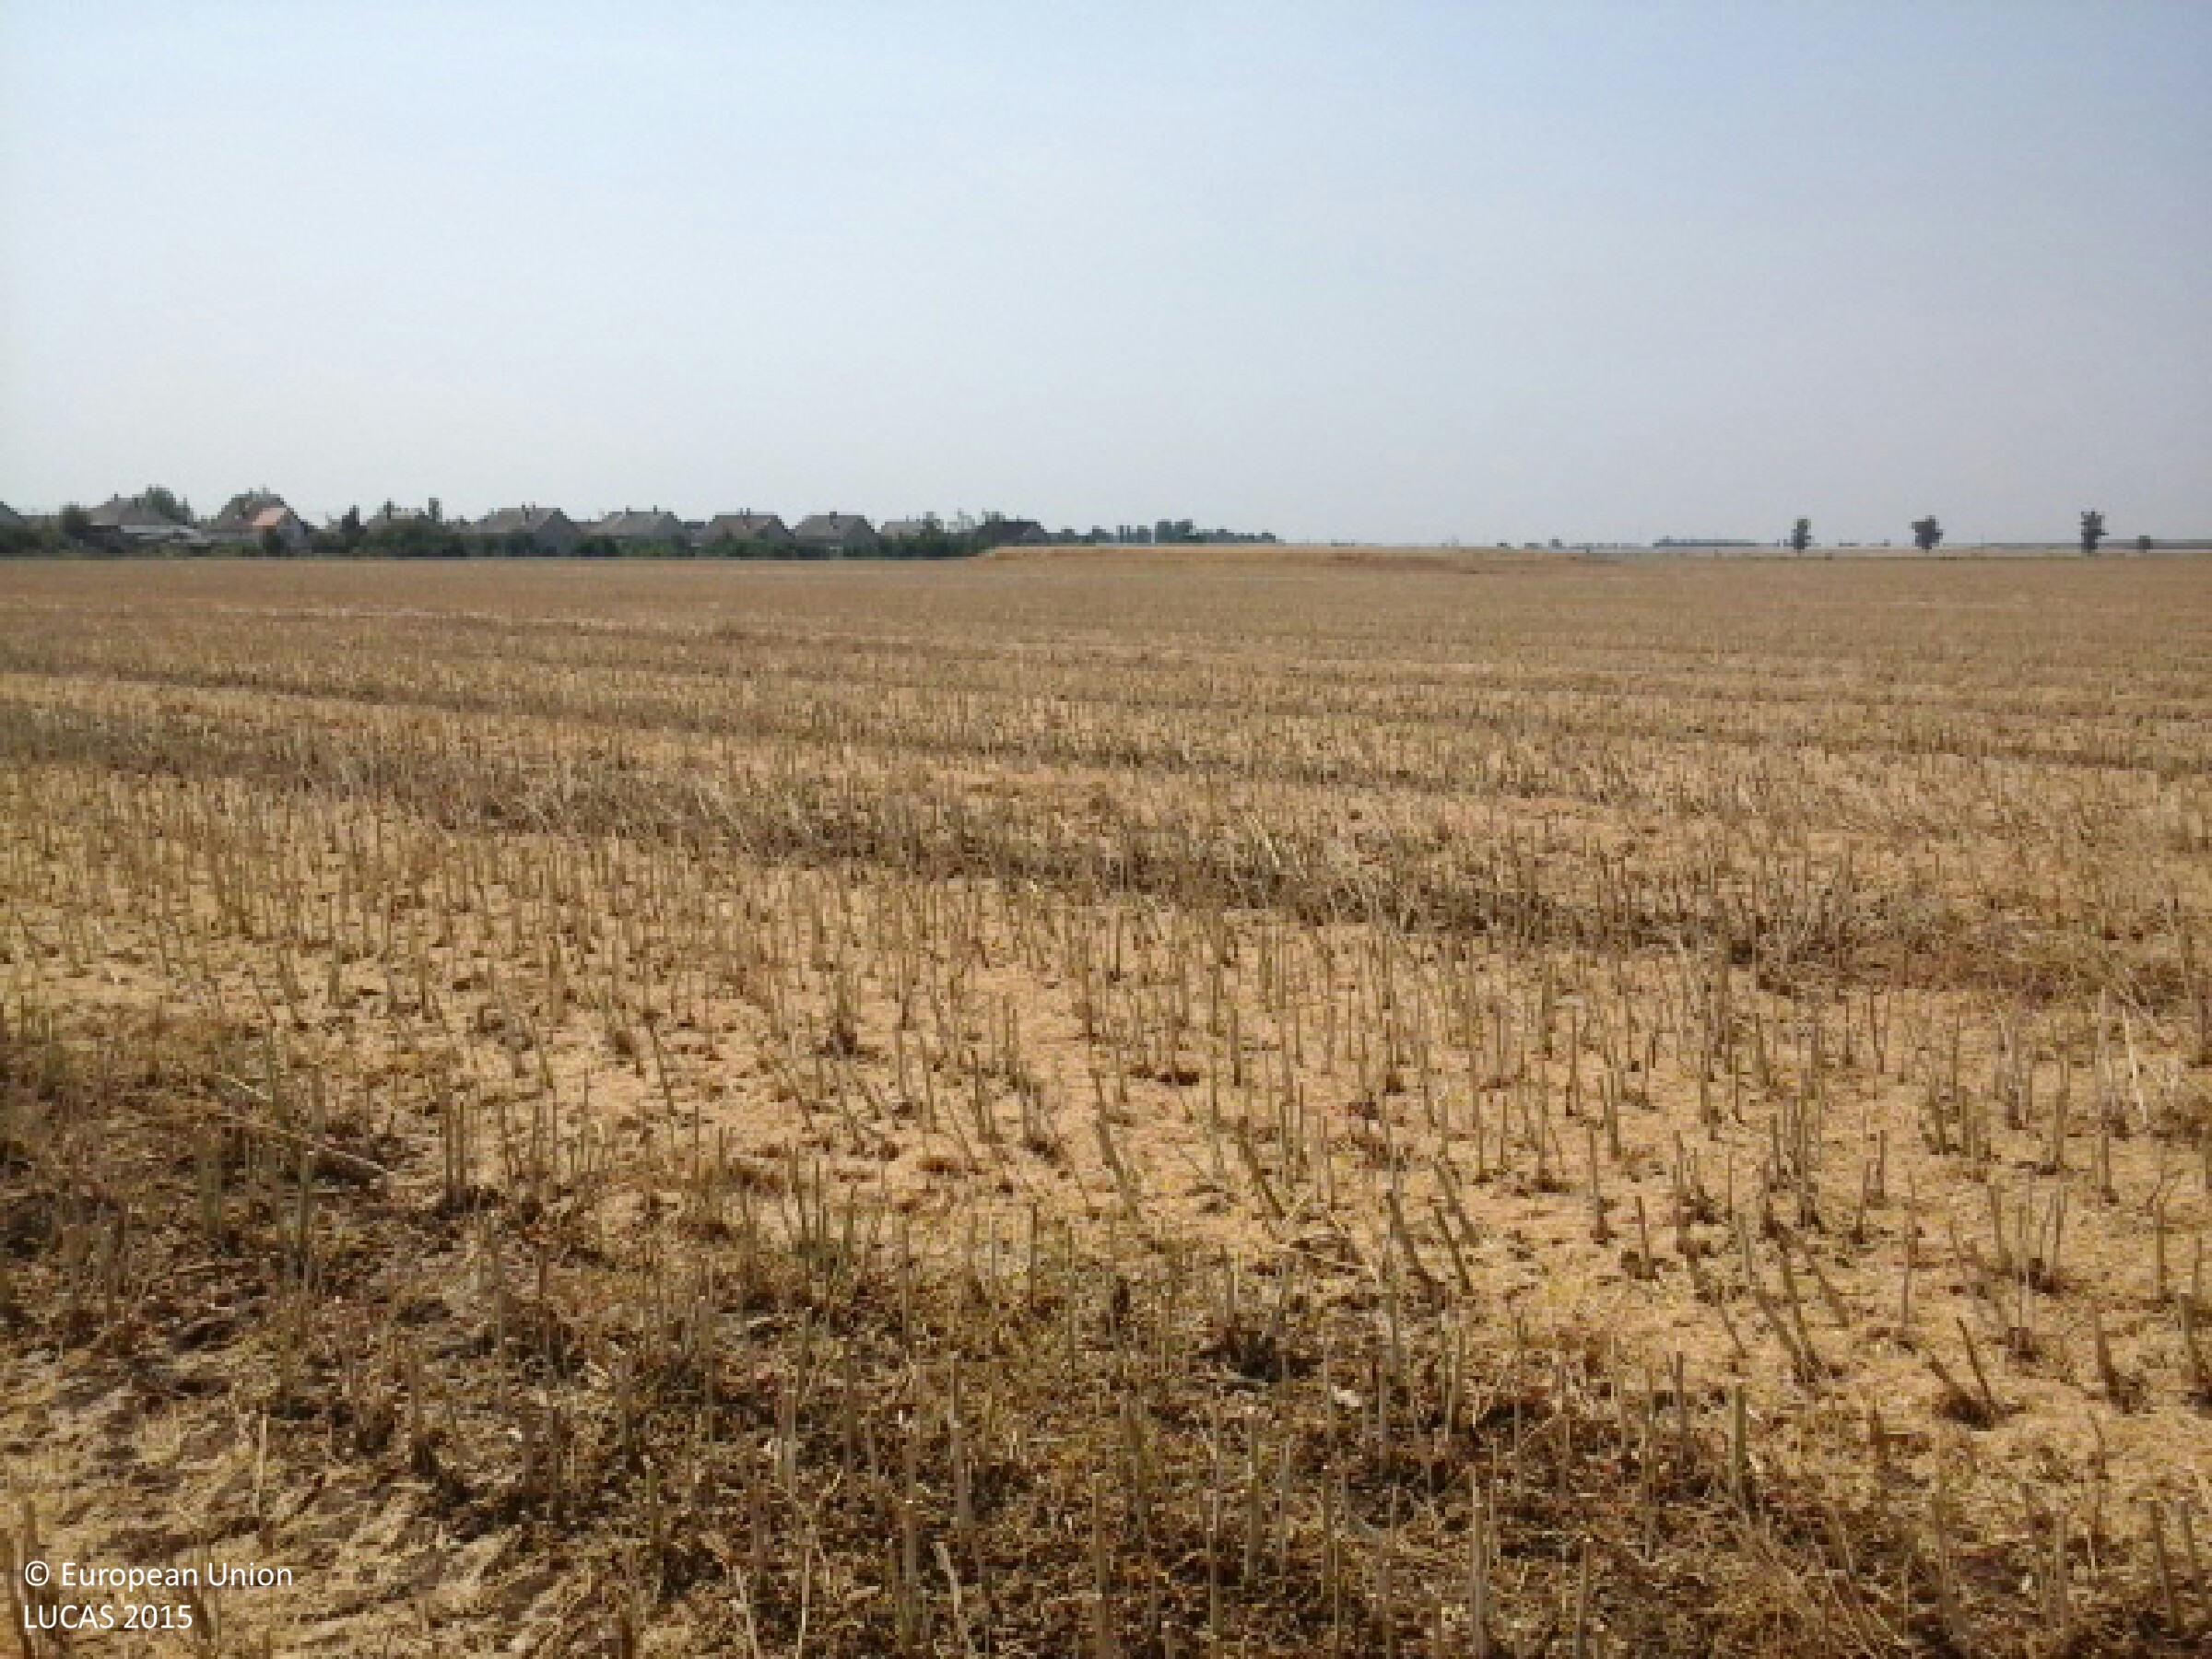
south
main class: Cropland
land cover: Rape and turnip rape
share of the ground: < 10 %
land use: Agriculture (excluding fallow land and kitchen gardens)
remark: Harvested field
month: July
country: HU
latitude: 48.0951
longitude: 21.1181
